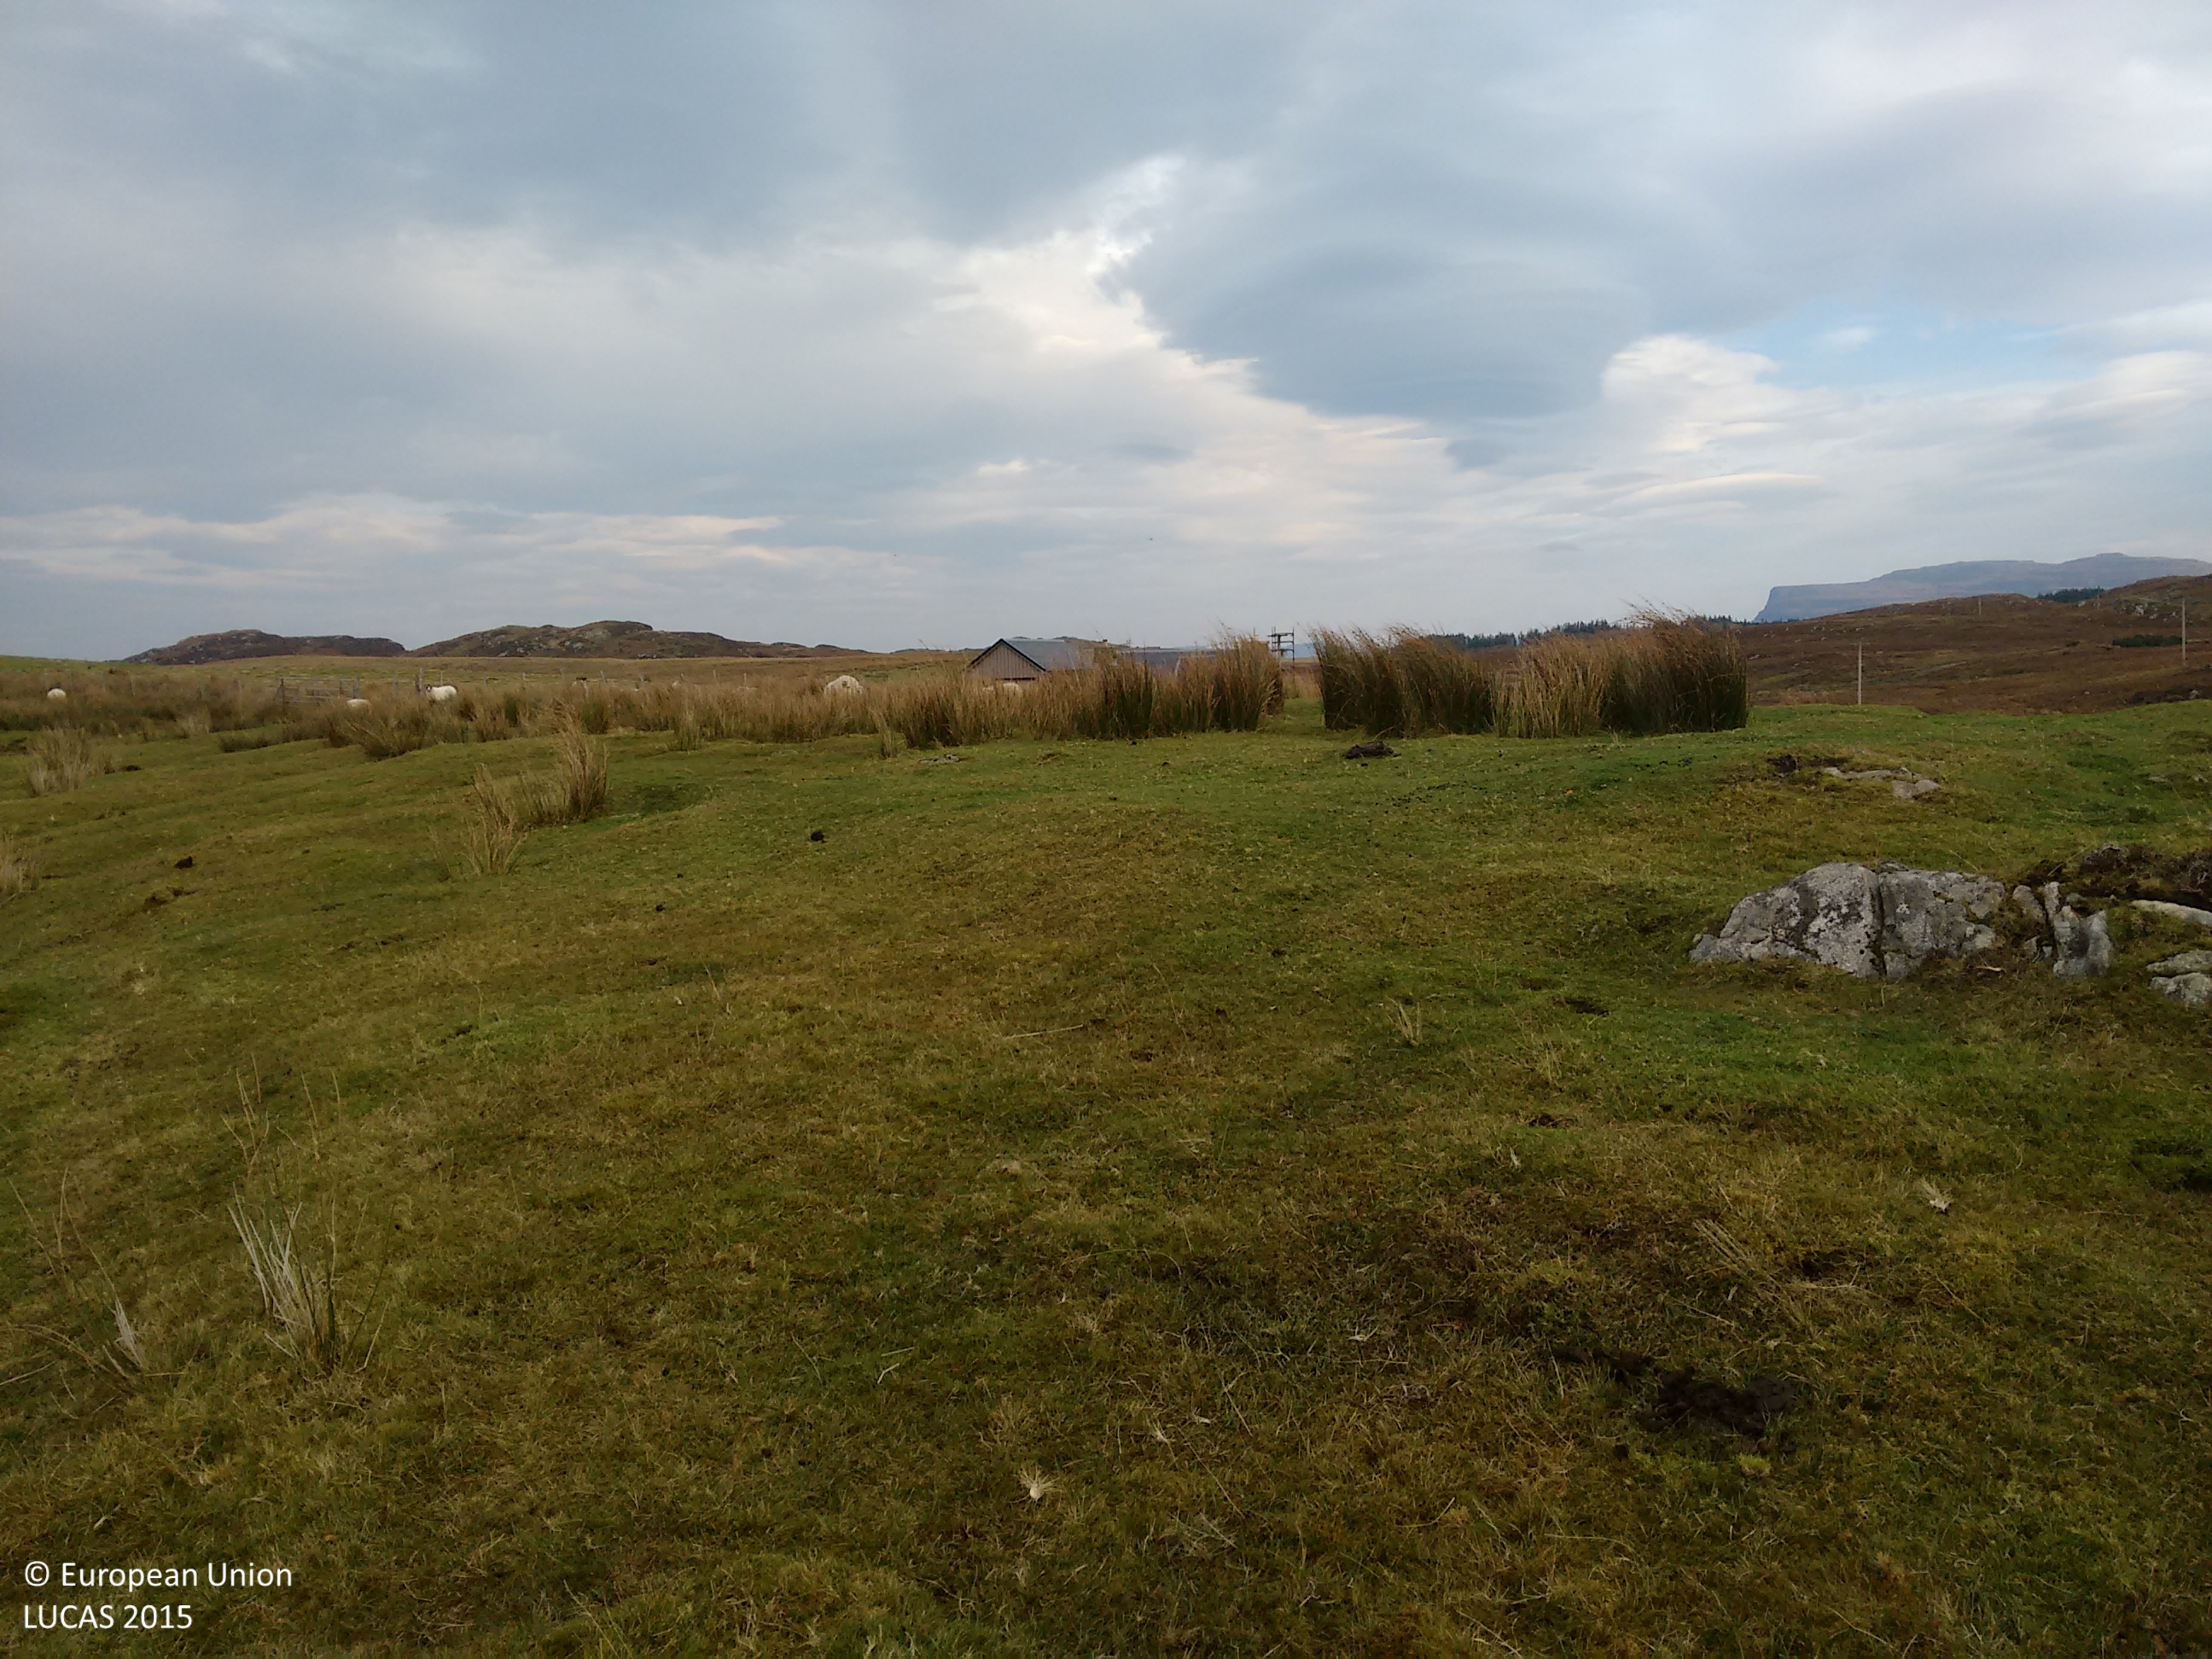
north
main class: Grassland
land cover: Grassland without tree/shrub cover
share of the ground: > 75 %
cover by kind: herbaceous plants 90 %, lichens and mosses 10 %
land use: Agriculture (excluding fallow land and kitchen gardens)
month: October
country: GB
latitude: 56.2996
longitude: -6.2533
